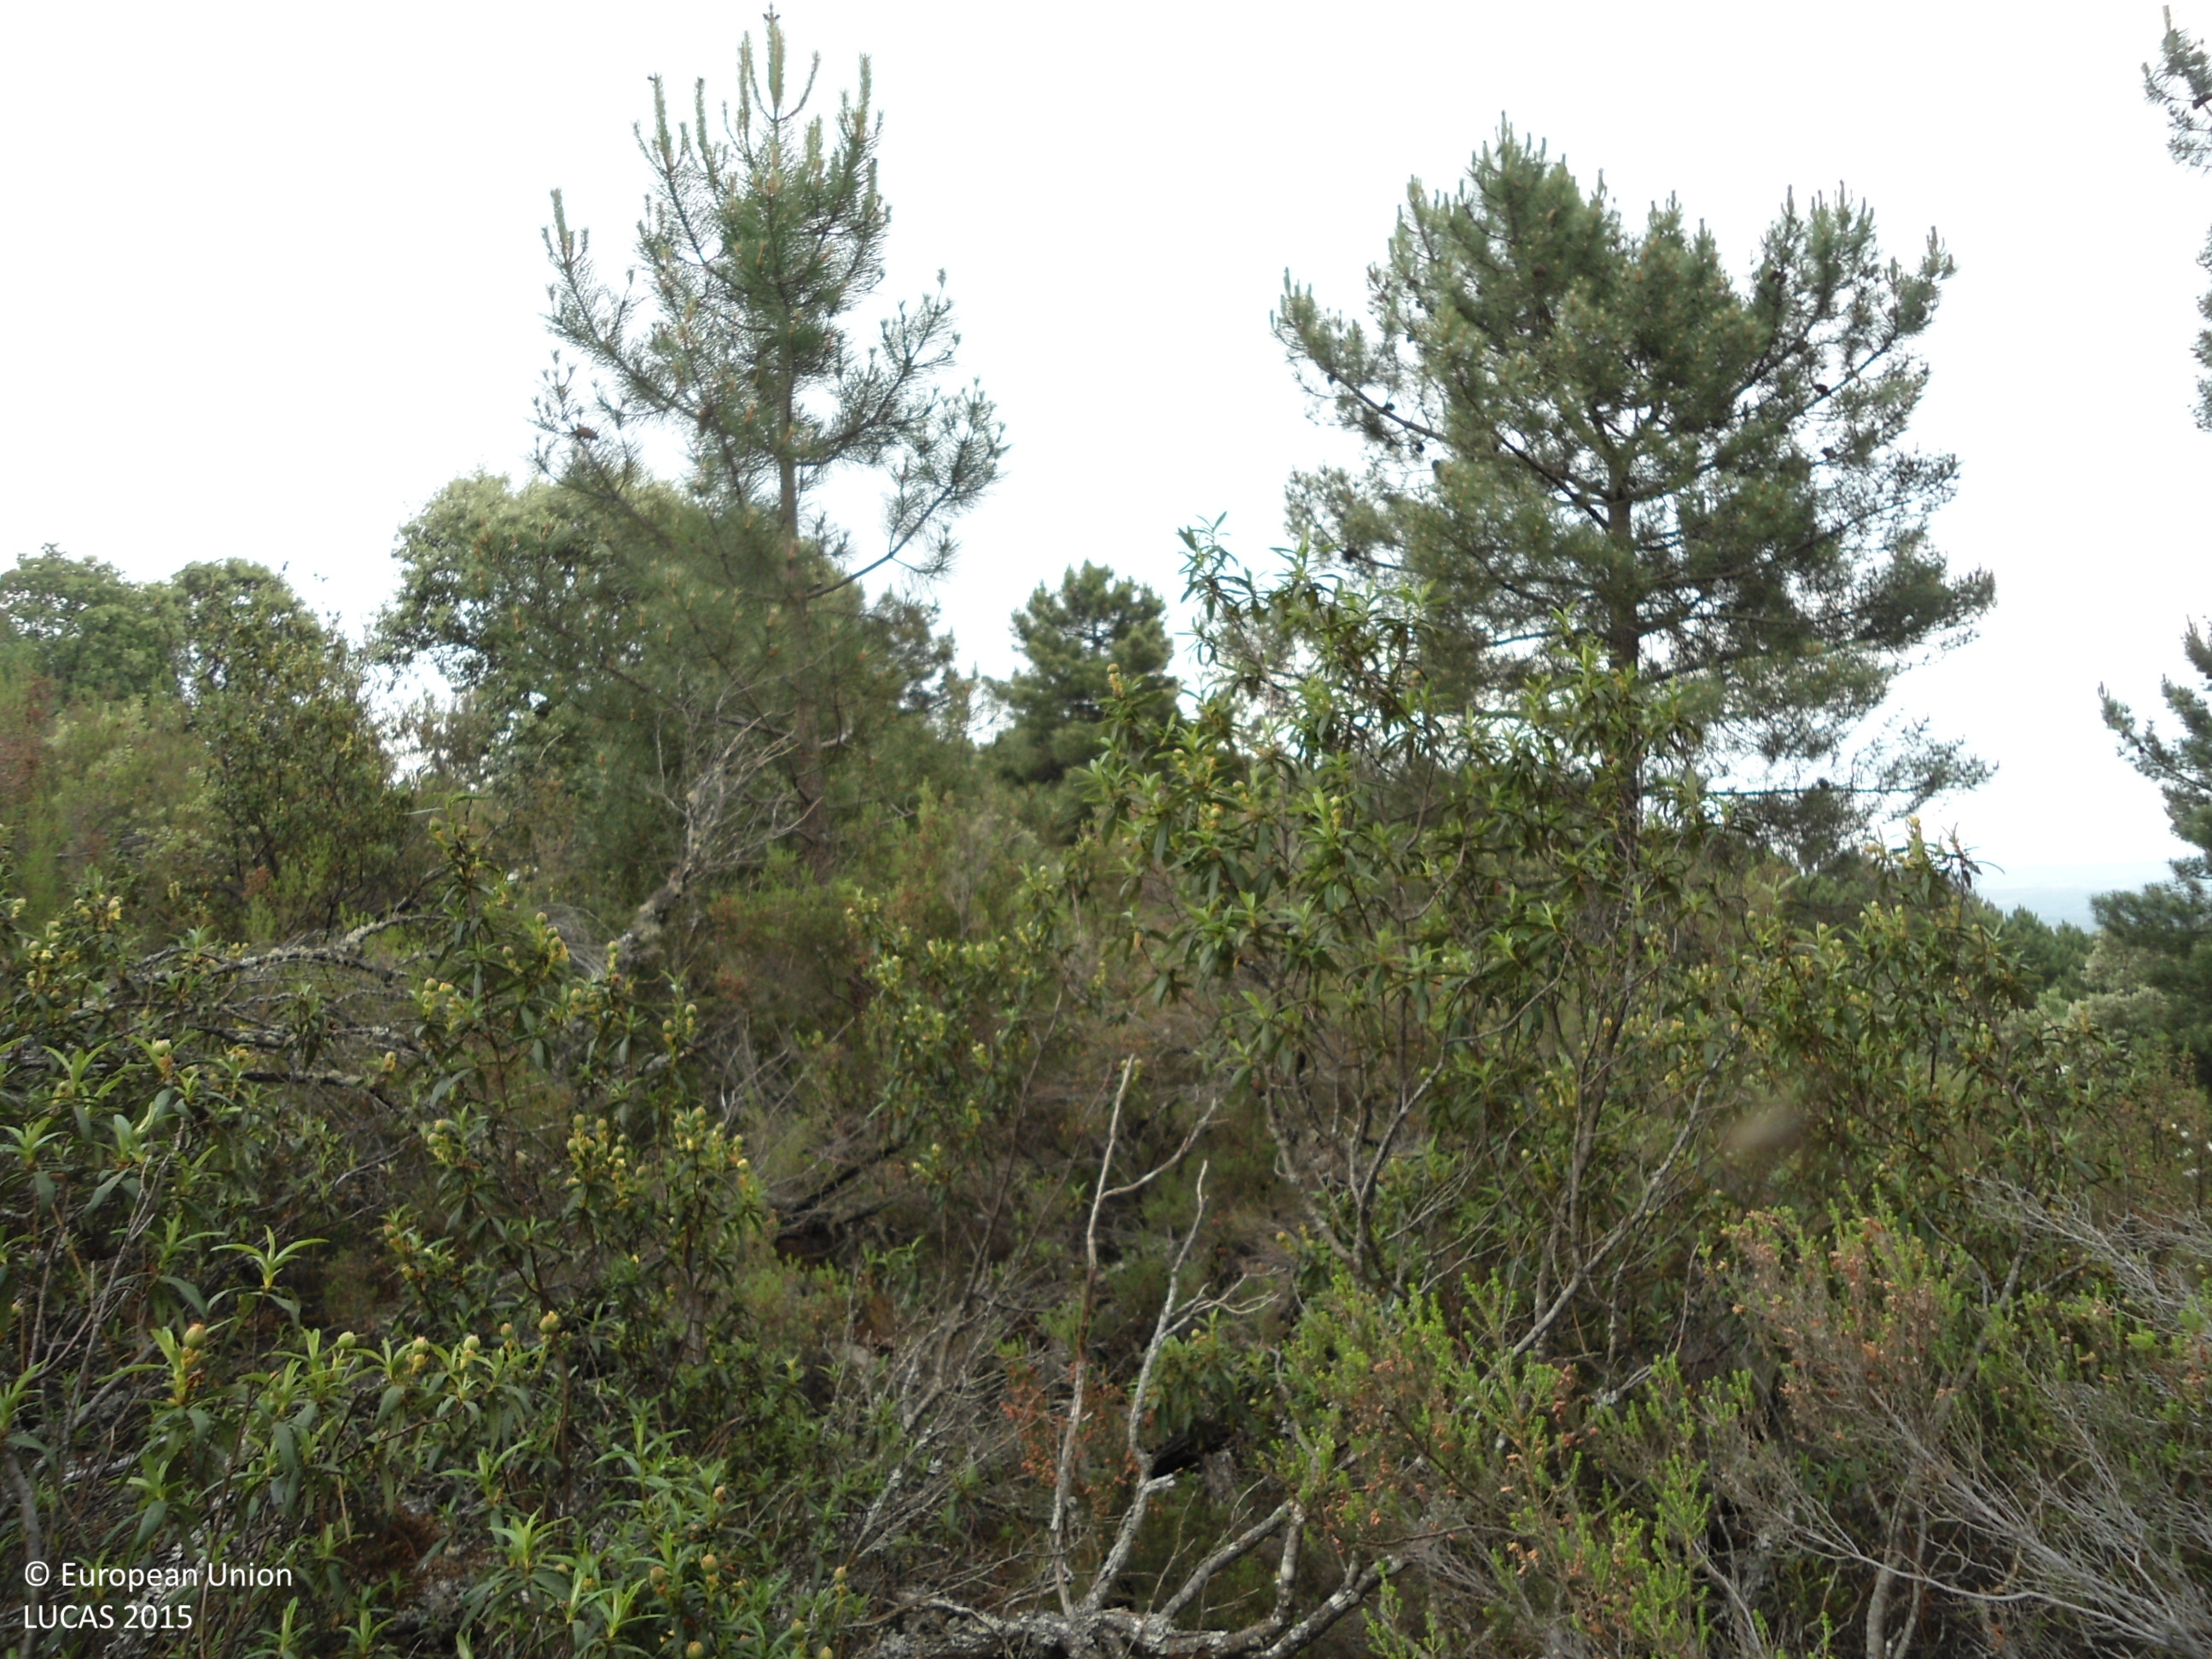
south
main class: Woodland
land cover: Pine dominated mixed woodland
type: coniferous forest of the mediterranean region
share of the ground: > 75 %
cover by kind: coniferous forest trees 65 %, broadleaved forest trees 25 %, shrubs 10 %
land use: Forestry
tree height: > 5 m
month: June
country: ES
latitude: 41.8751
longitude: -6.1867
